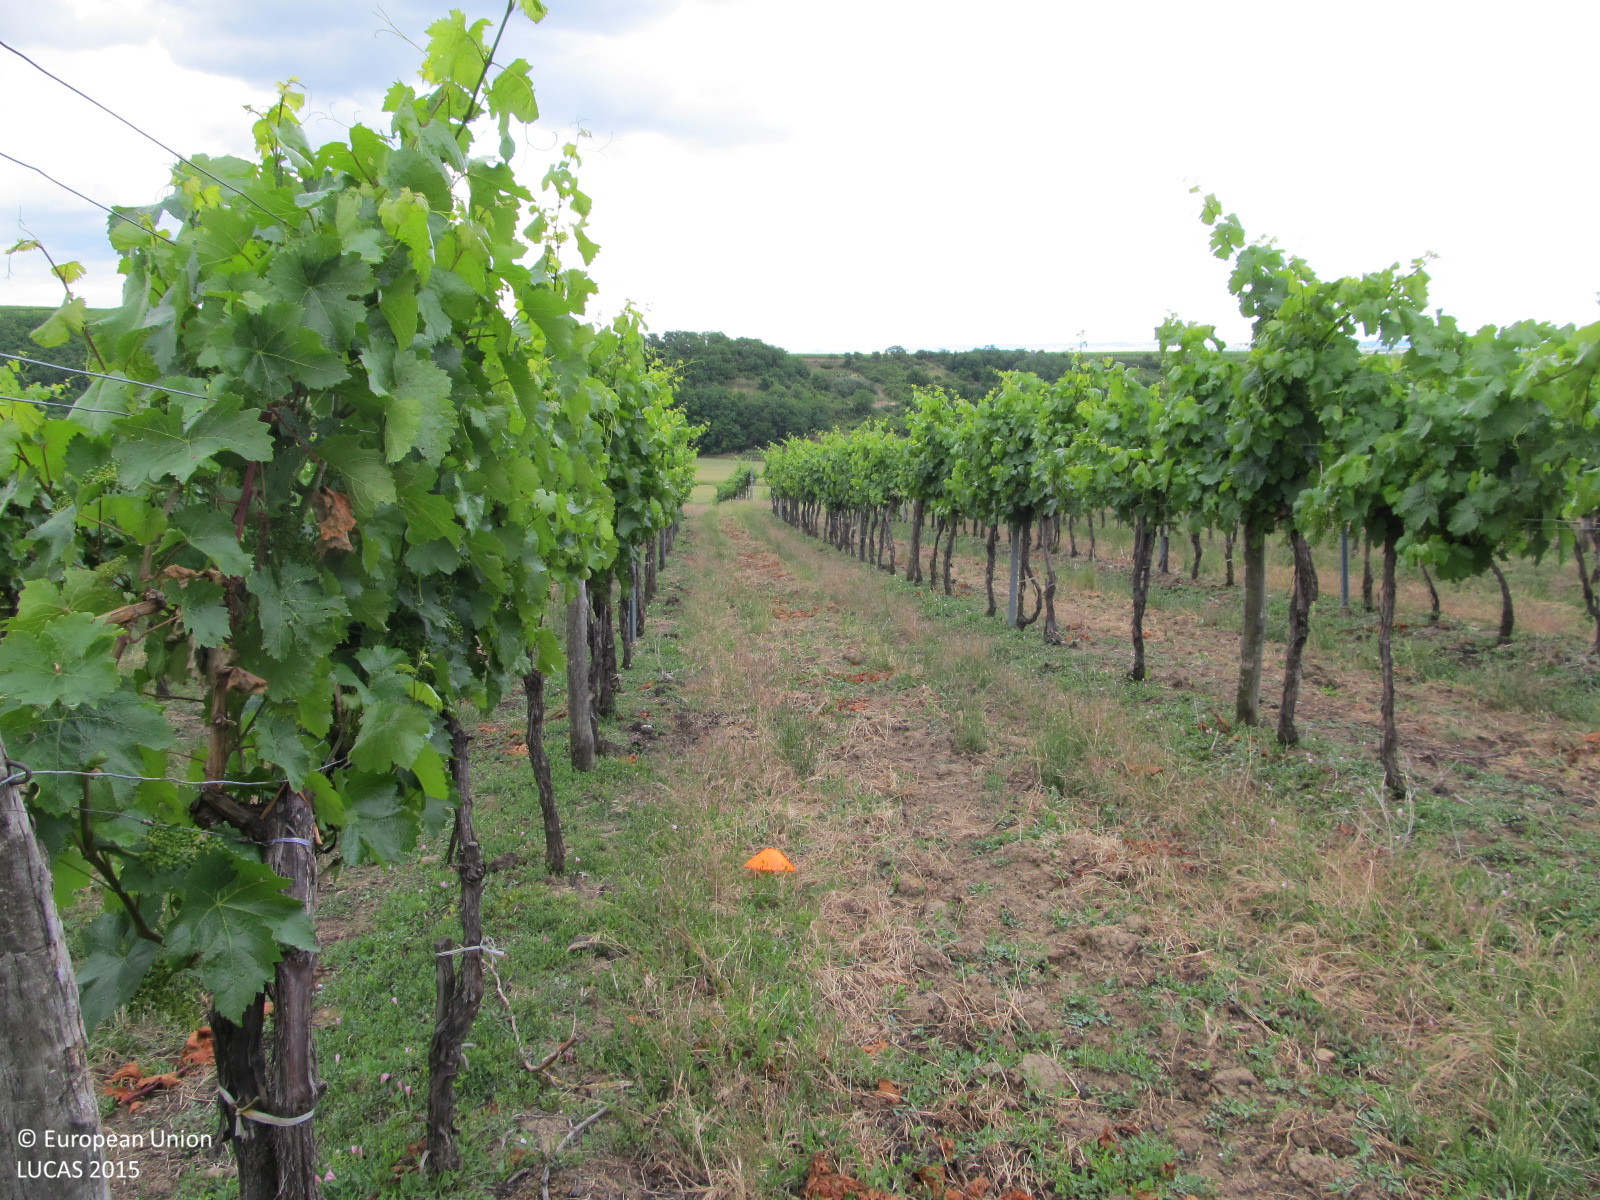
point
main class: Cropland
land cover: Vineyards
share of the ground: 25 - 50 %
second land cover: Grassland without tree/shrub cover
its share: 50 - 75 %
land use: Agriculture (excluding fallow land and kitchen gardens)
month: June
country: AT
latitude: 48.7218
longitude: 16.1082
